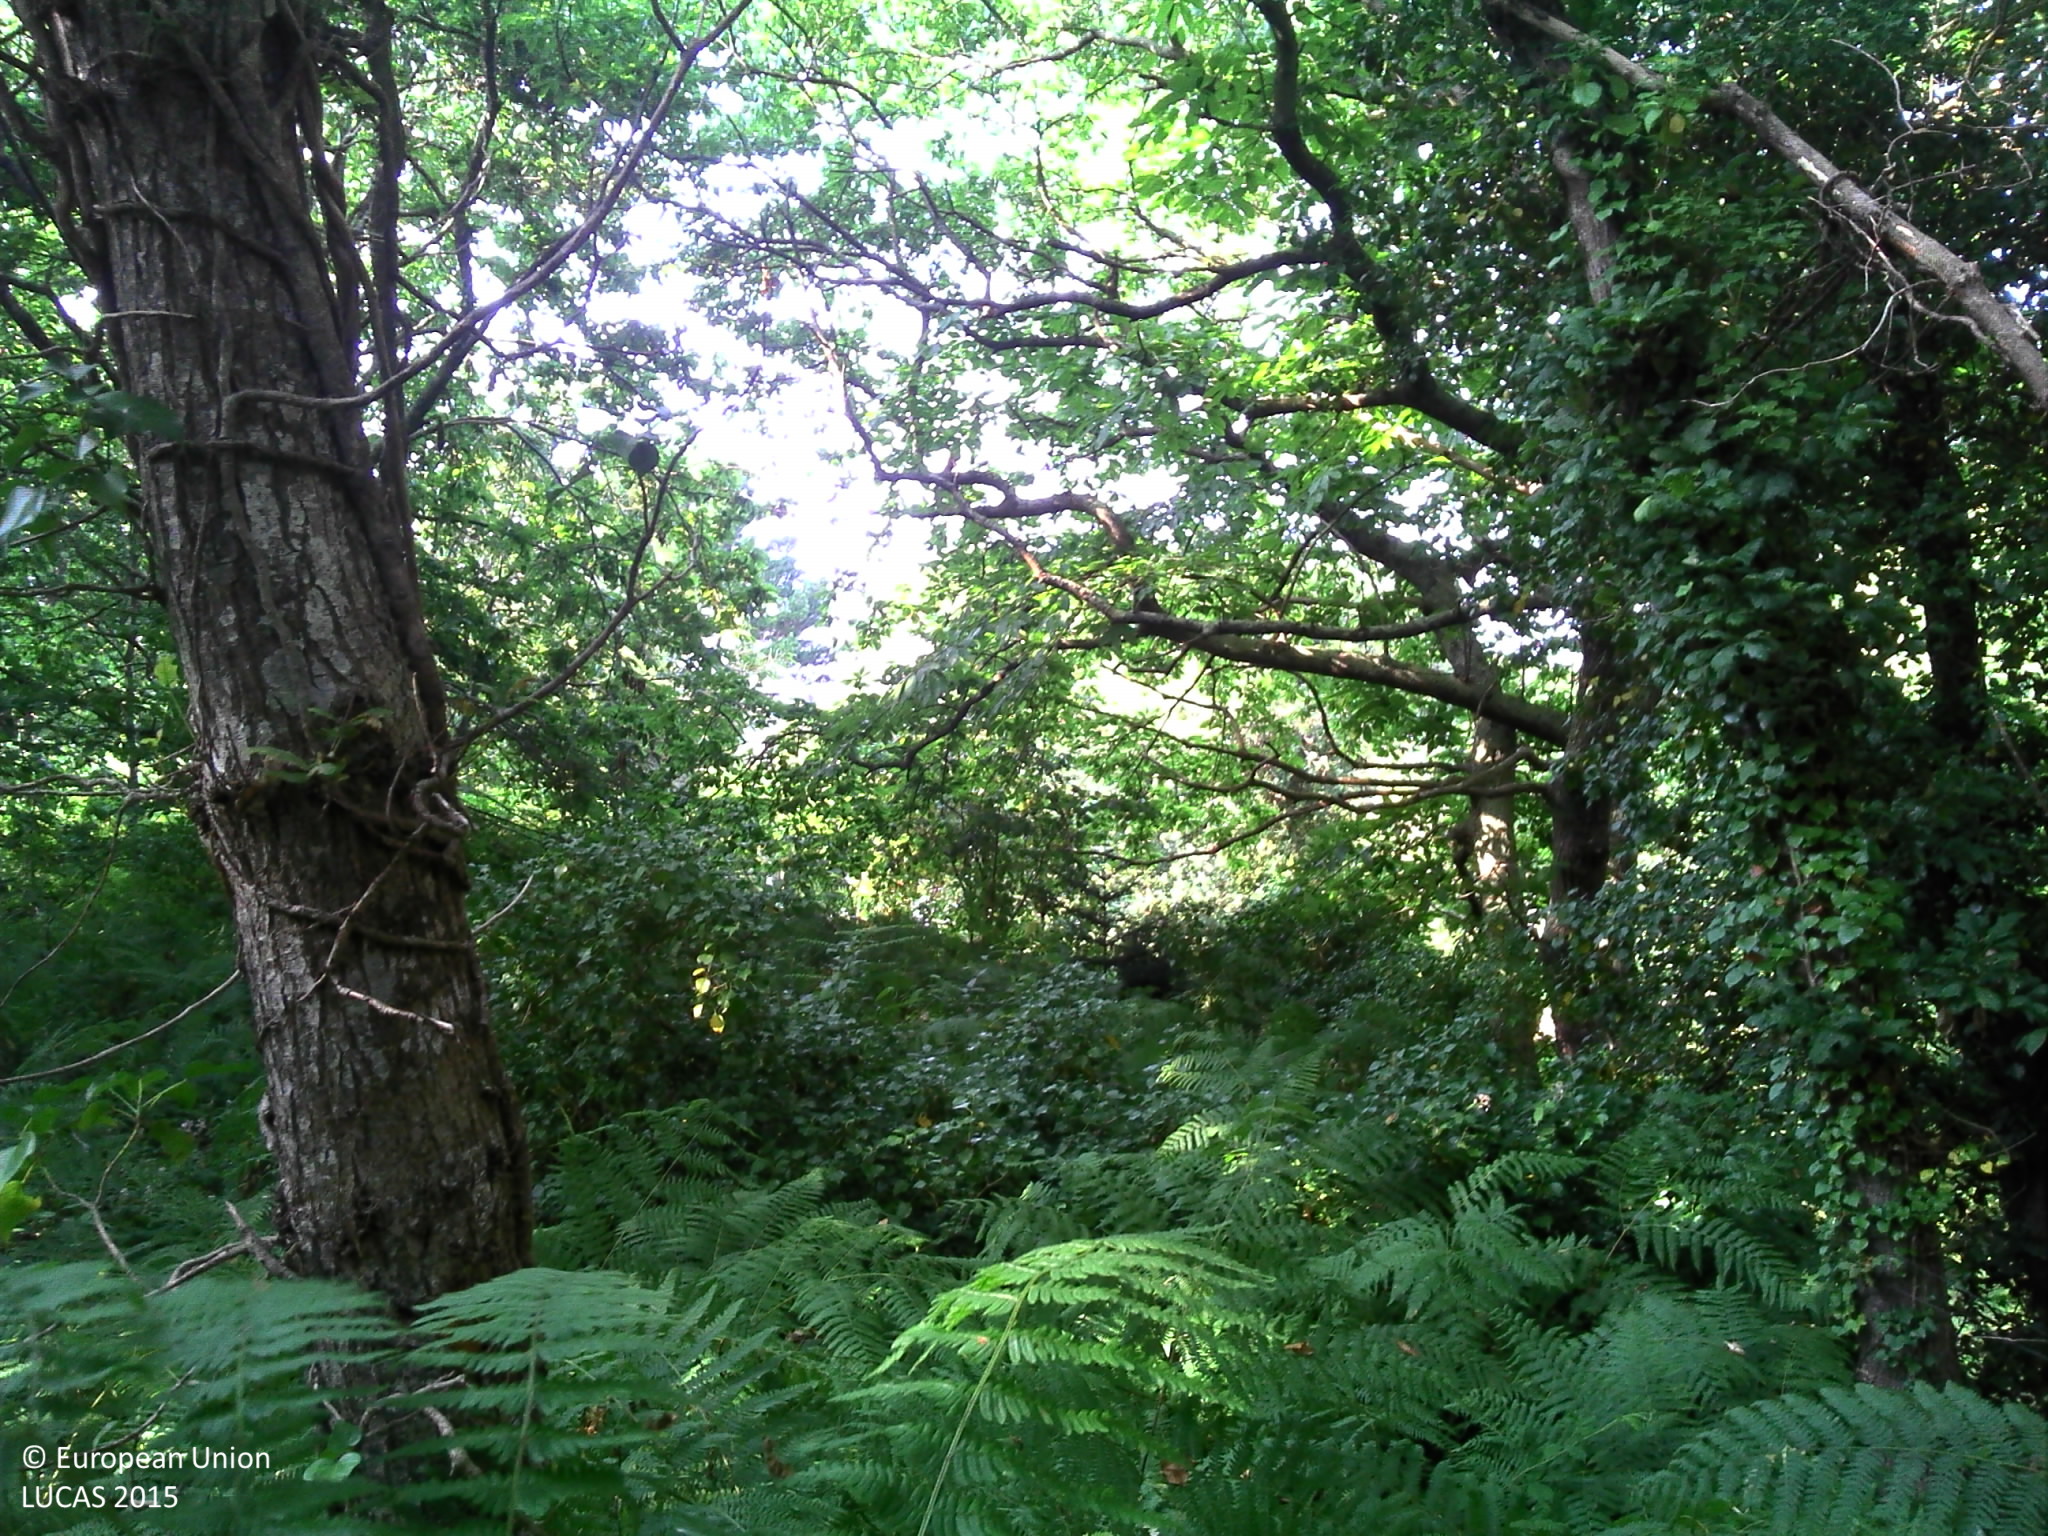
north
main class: Woodland
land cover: Broadleaved woodland
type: acidophilous oak and oak-birch forest
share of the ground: > 75 %
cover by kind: broadleaved forest trees 65 %, herbaceous plants 20 %, unconsolidated bare surface 10 %, lichens and mosses 5 %
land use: Forestry
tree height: > 5 m
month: July
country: FR
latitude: 48.8120
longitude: -3.4933
